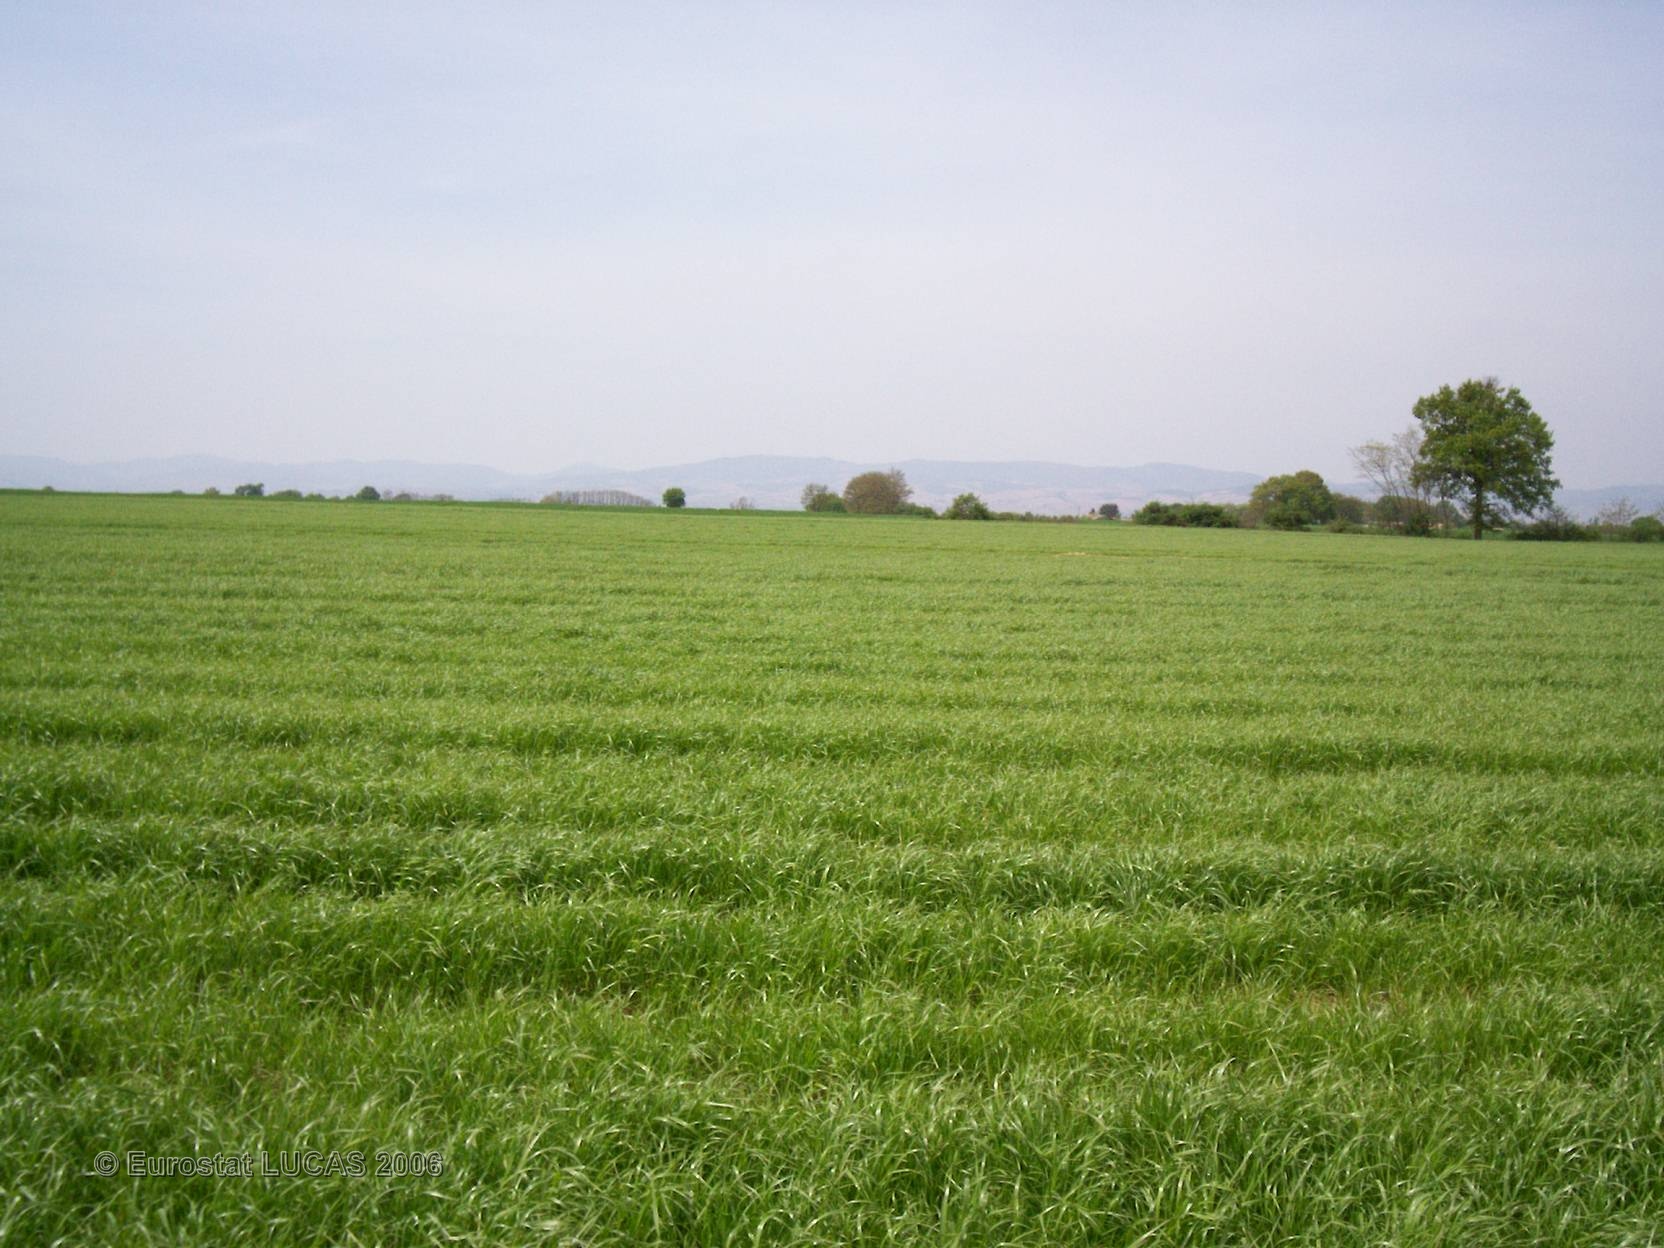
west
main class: Grassland
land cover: Grassland without tree/shrub cover
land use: Agriculture (excluding fallow land and kitchen gardens)
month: May
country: FR
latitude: 46.1735
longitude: 4.8603
